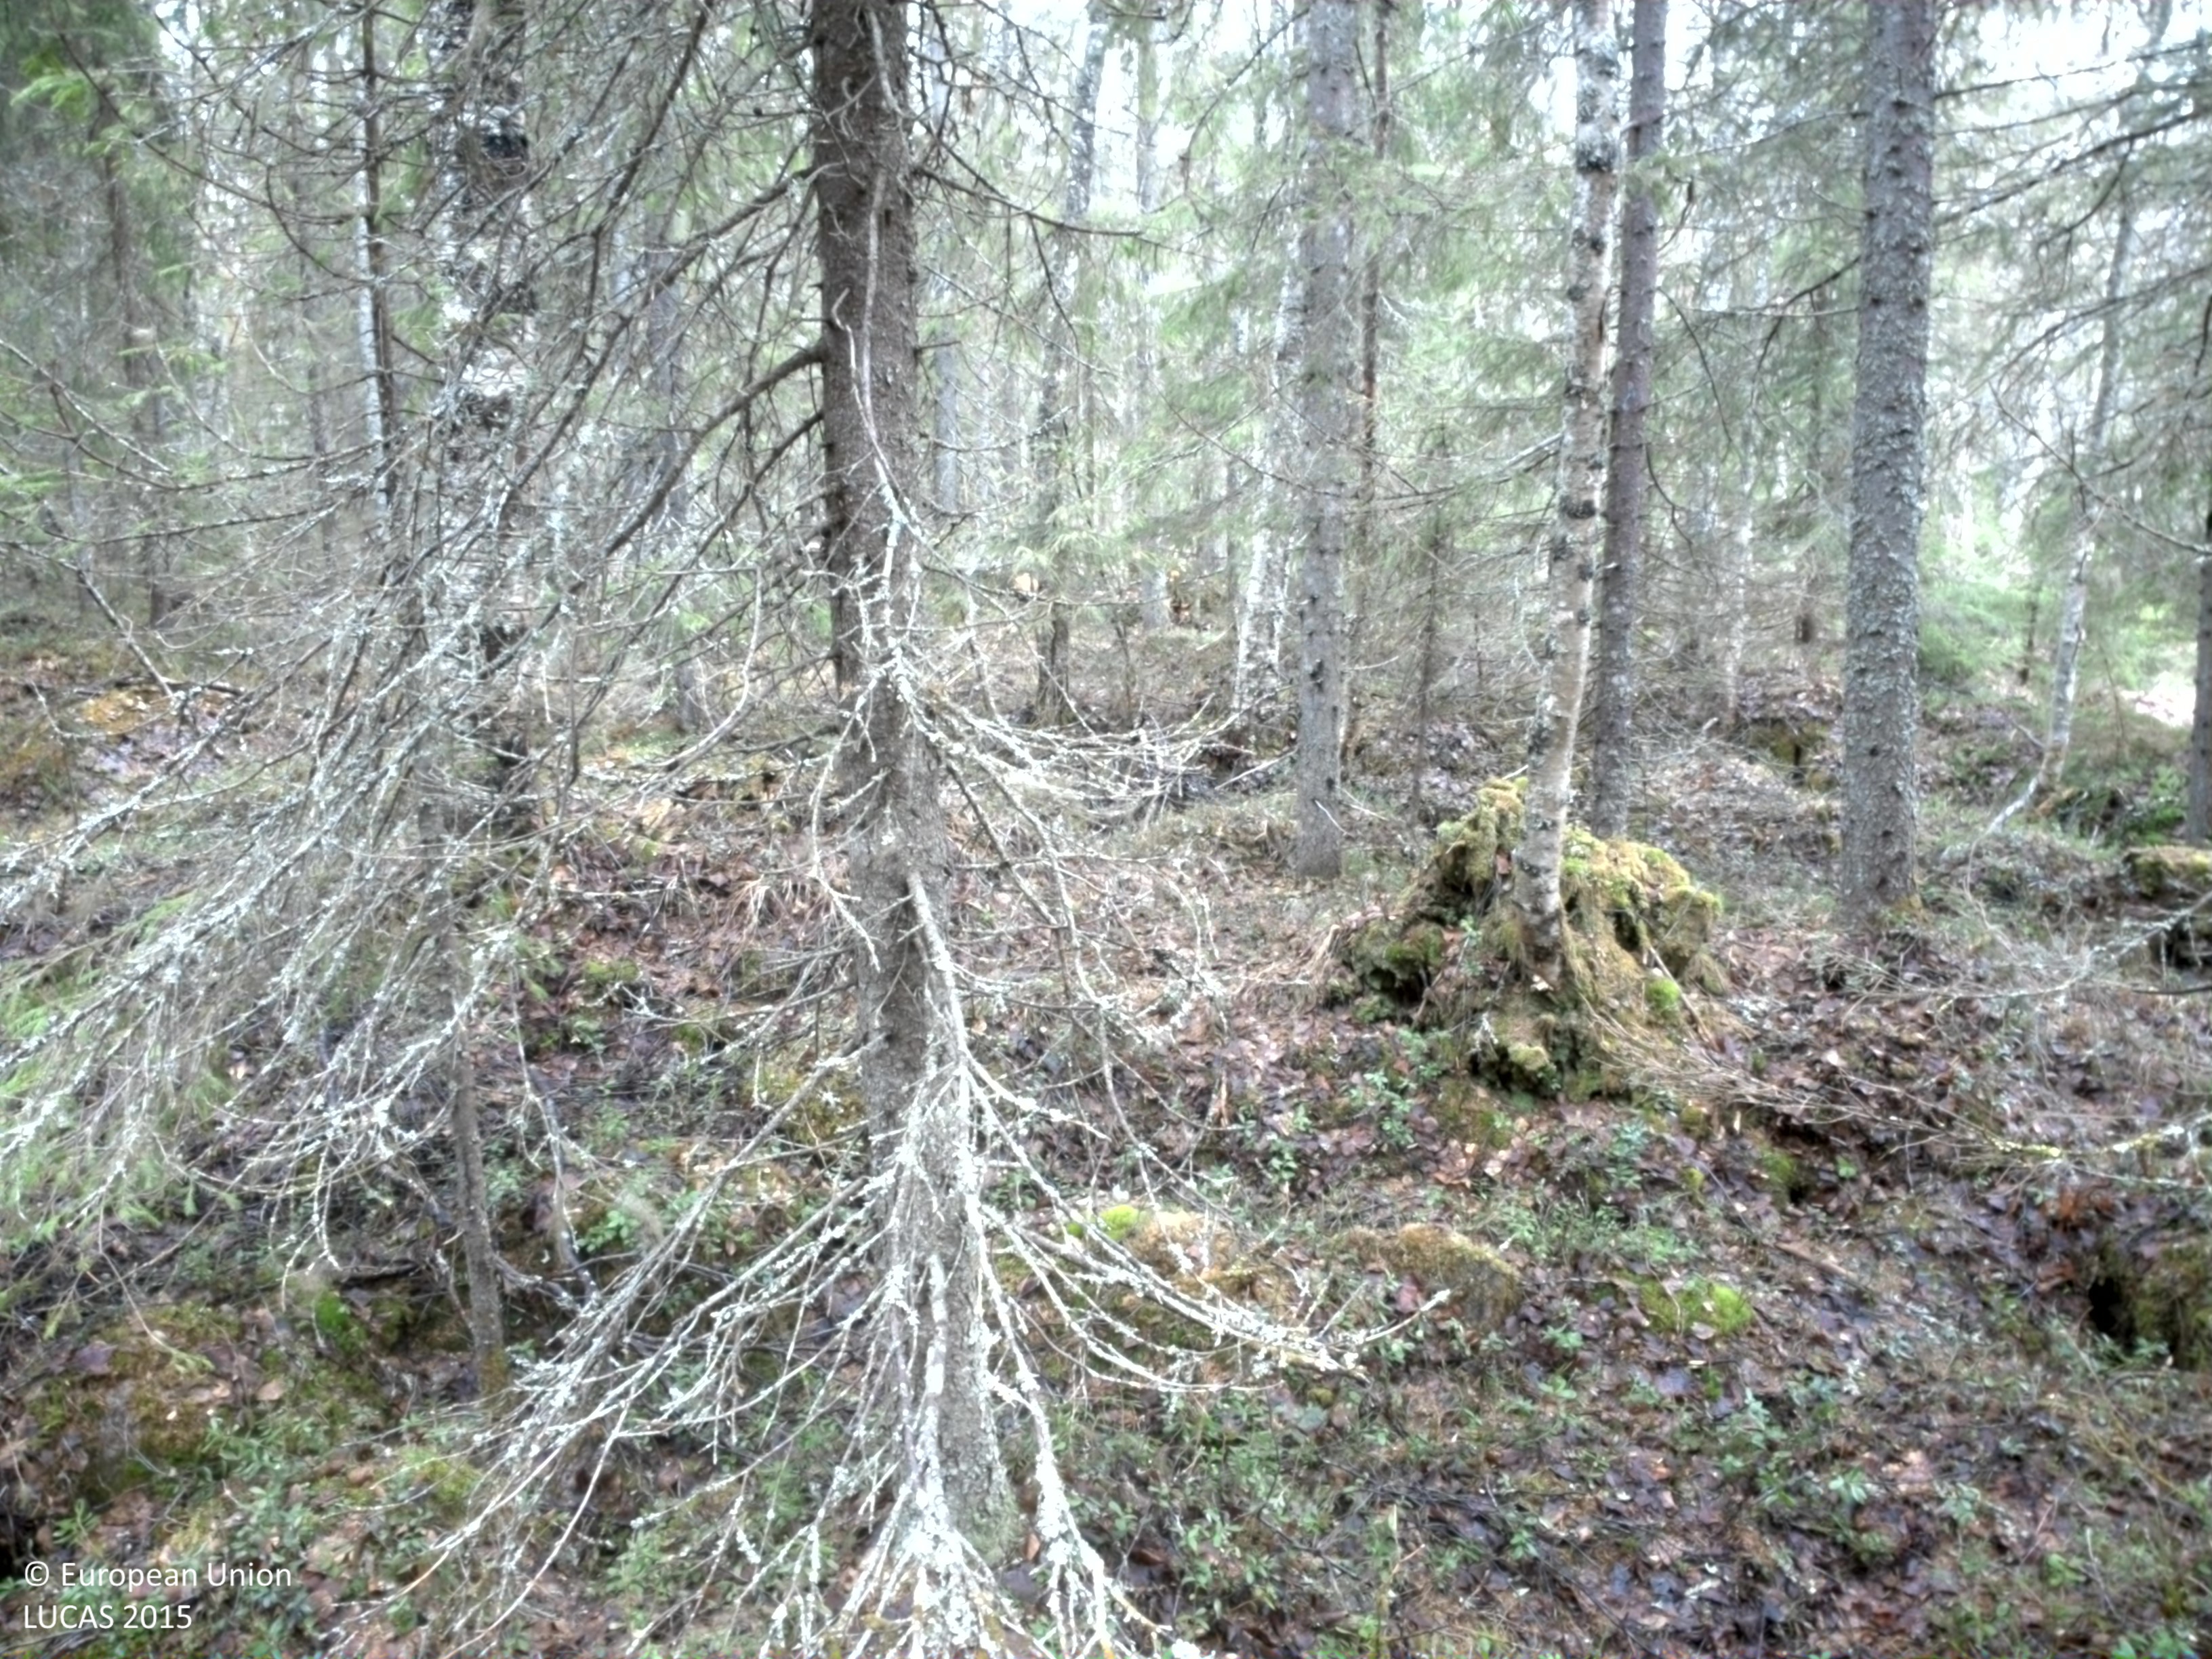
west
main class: Woodland
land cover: Spruce dominated mixed woodland
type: boreal forest
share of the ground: > 75 %
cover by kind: coniferous forest trees 60 %, broadleaved forest trees 20 %, lichens and mosses 15 %, shrubs 5 %
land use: Forestry
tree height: > 5 m
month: May
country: SE
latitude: 65.8890
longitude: 22.9060
